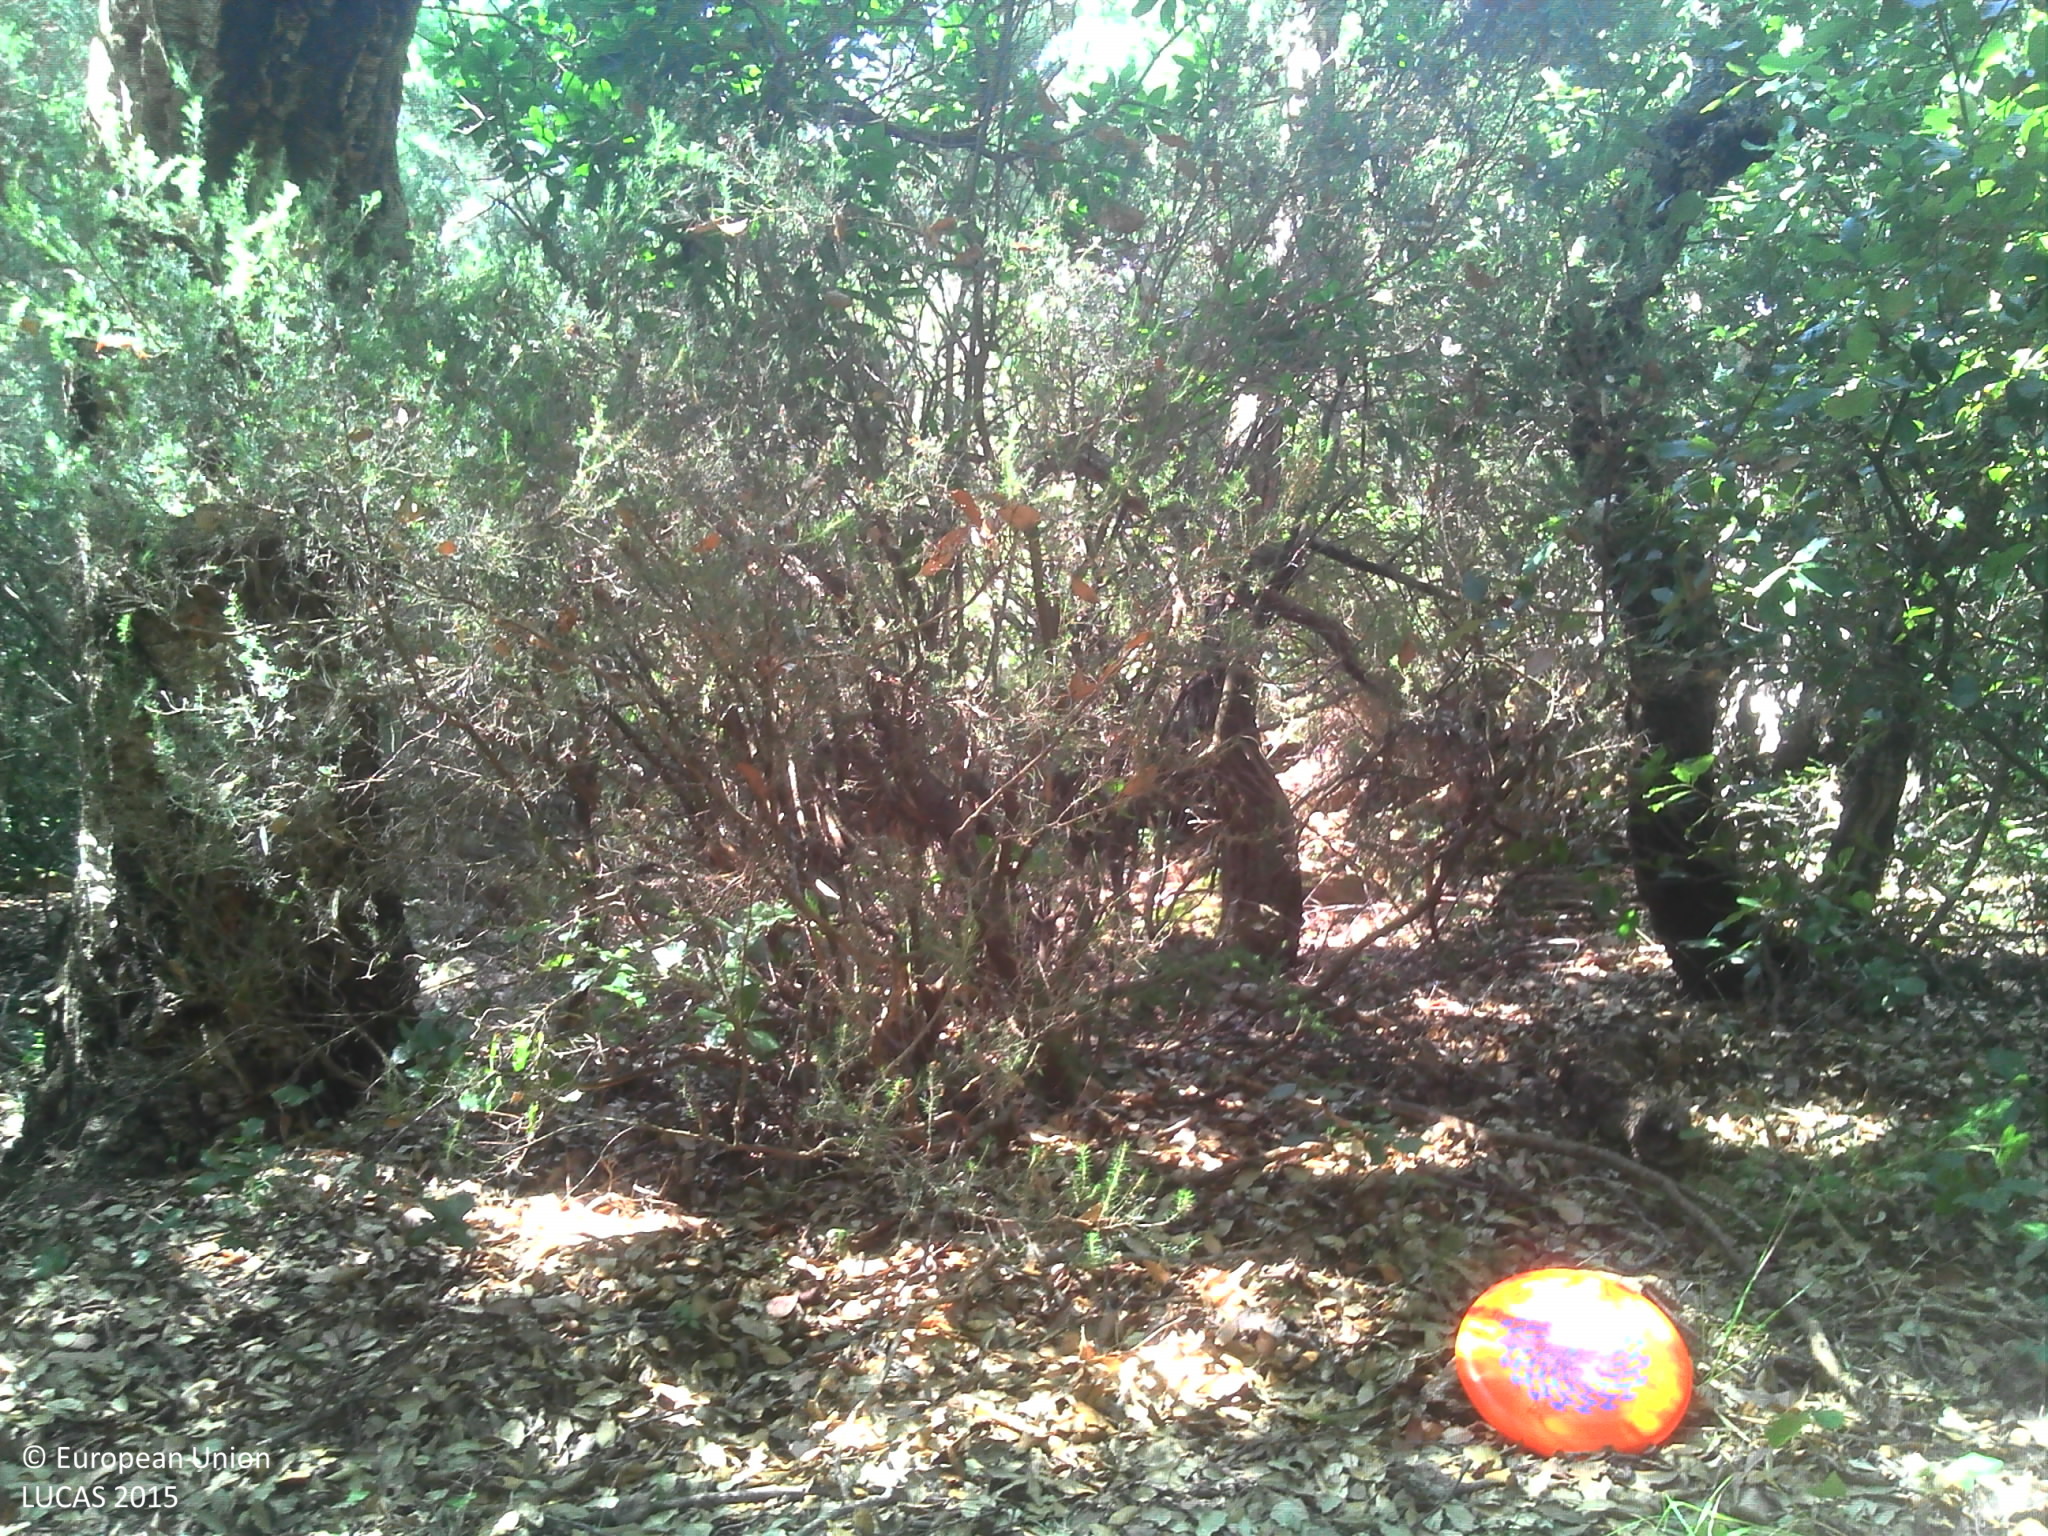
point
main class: Woodland
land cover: Broadleaved woodland
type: thermophilous deciduous forest
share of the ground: > 75 %
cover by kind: broadleaved forest trees 90 %, unconsolidated bare surface 10 %
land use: Semi-natural and natural areas not in use
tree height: > 5 m
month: July
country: FR
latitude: 43.1677
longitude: 6.3809
